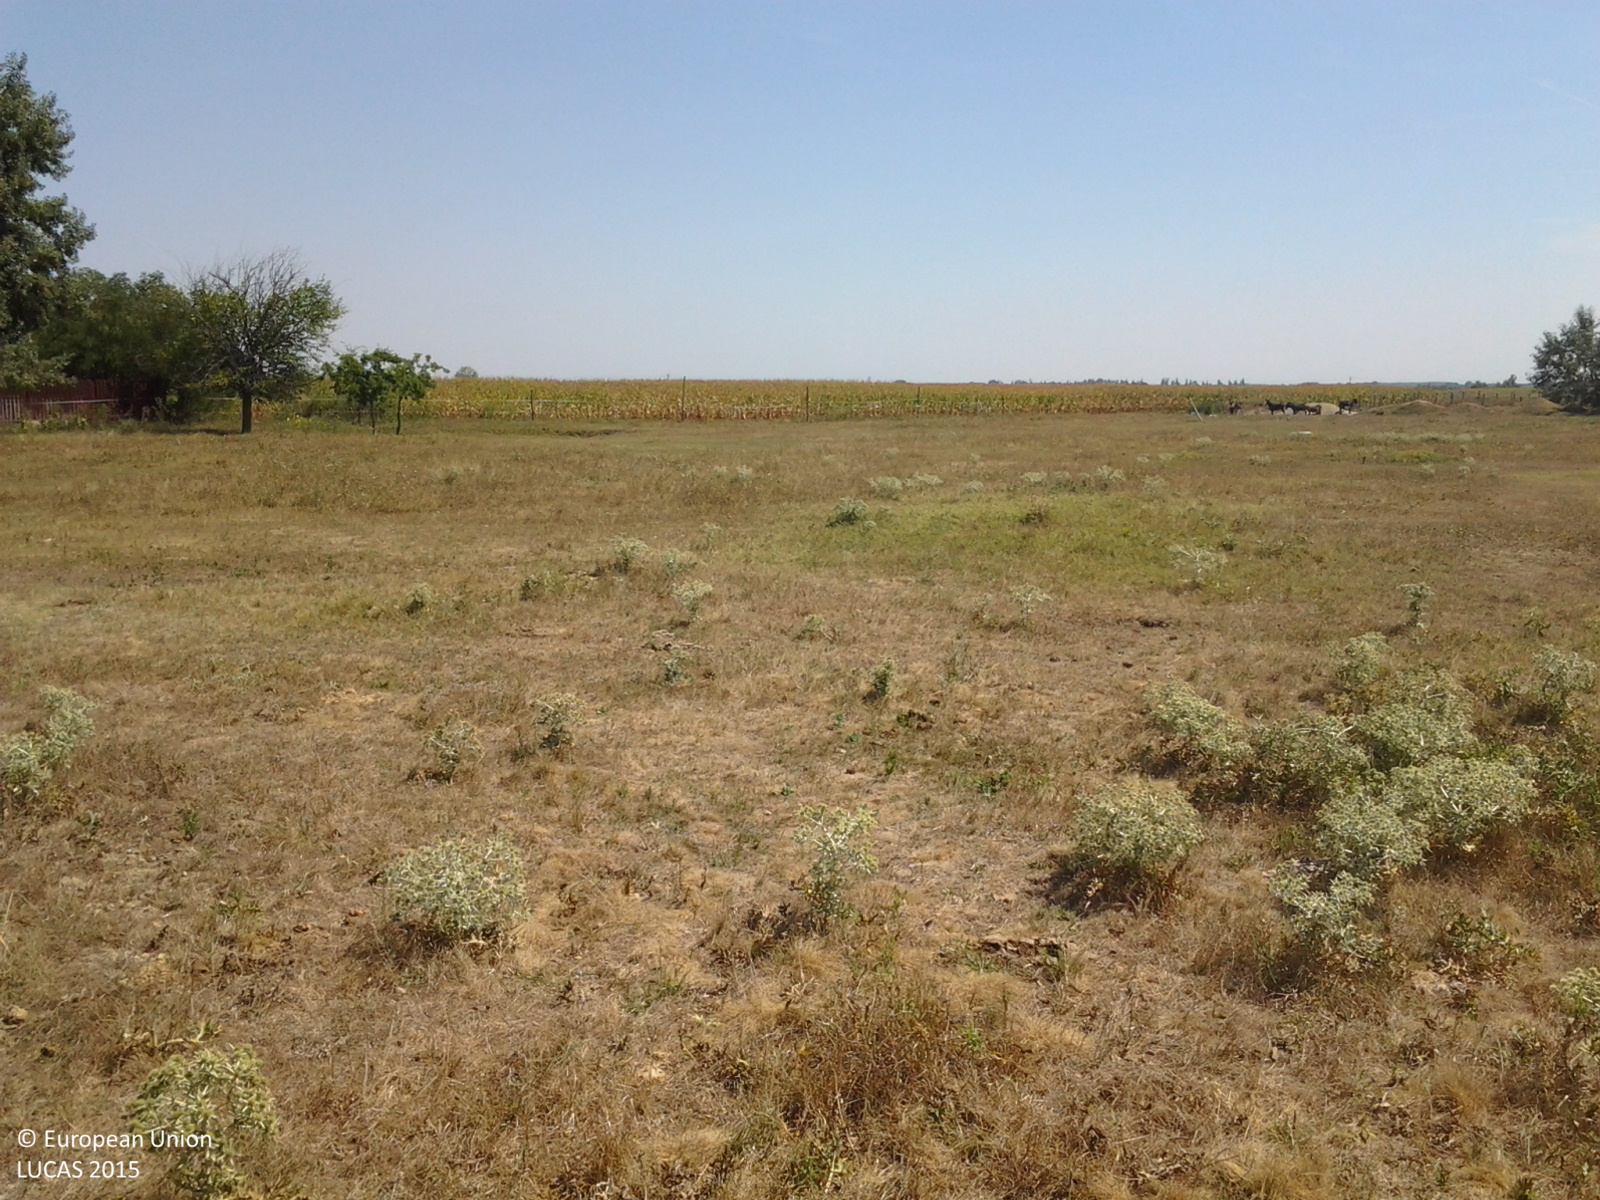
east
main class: Grassland
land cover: Grassland without tree/shrub cover
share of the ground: > 75 %
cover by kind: herbaceous plants 100 %
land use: Agriculture (excluding fallow land and kitchen gardens)
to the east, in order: Grassland without tree/shrub cover; Fences; Maize
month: August
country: HU
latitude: 47.3883
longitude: 19.7867
